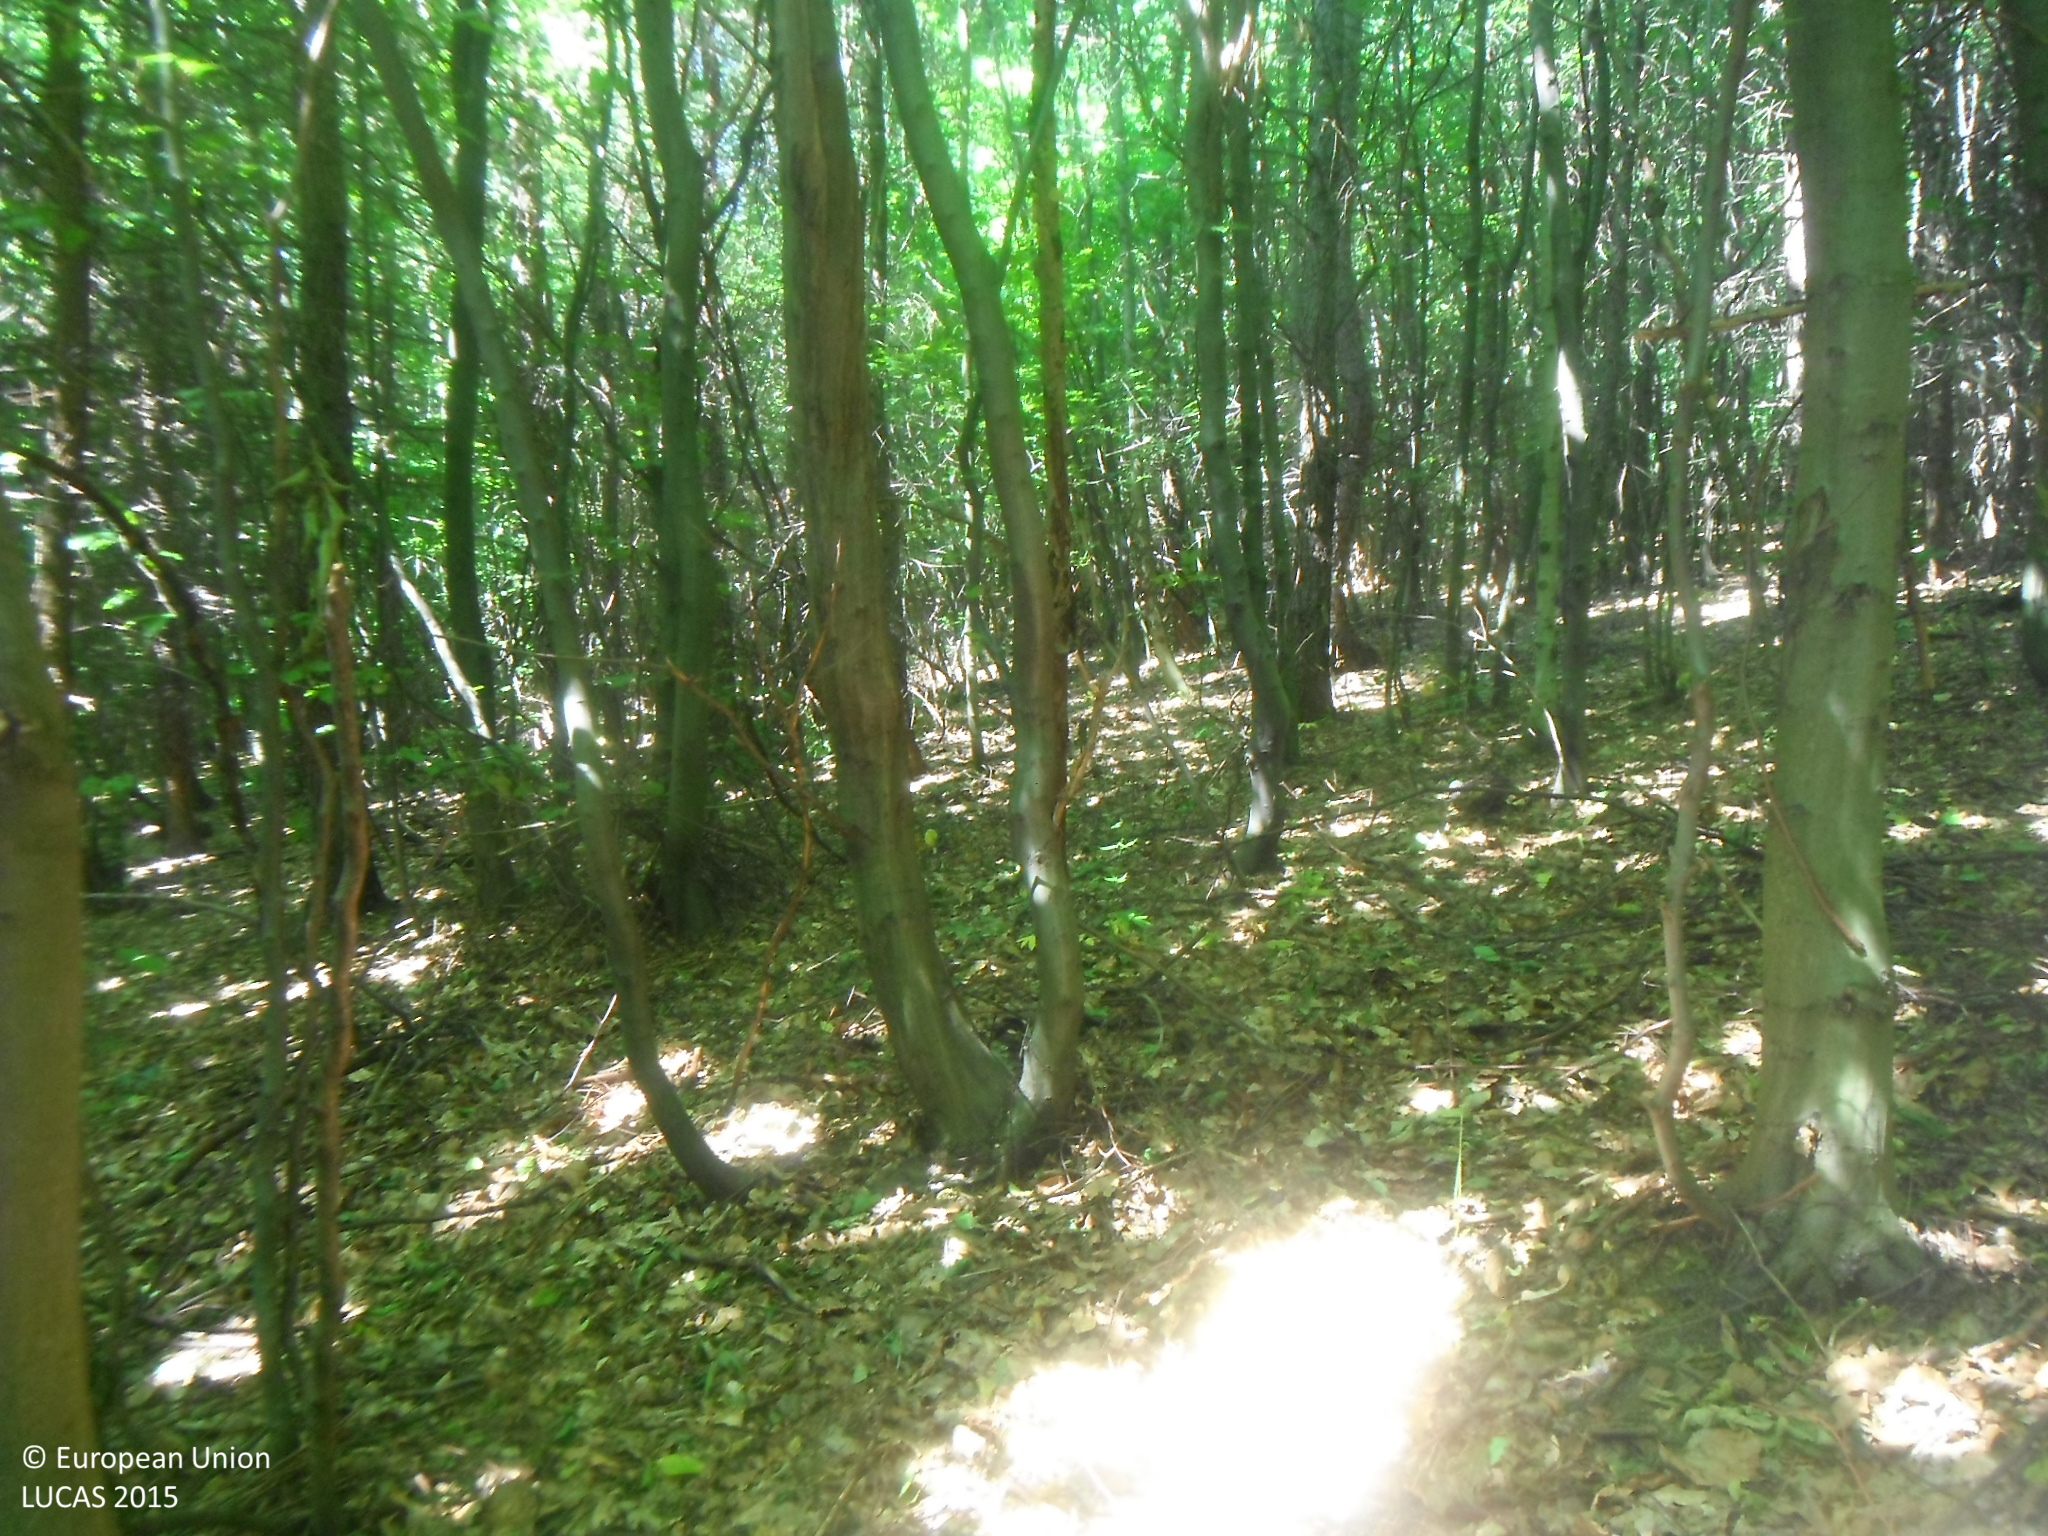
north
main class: Woodland
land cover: Broadleaved woodland
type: beech forest
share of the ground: > 75 %
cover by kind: broadleaved forest trees 95 %, herbaceous plants 5 %
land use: Forestry
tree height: > 5 m
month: June
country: SK
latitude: 49.0287
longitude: 21.5790
